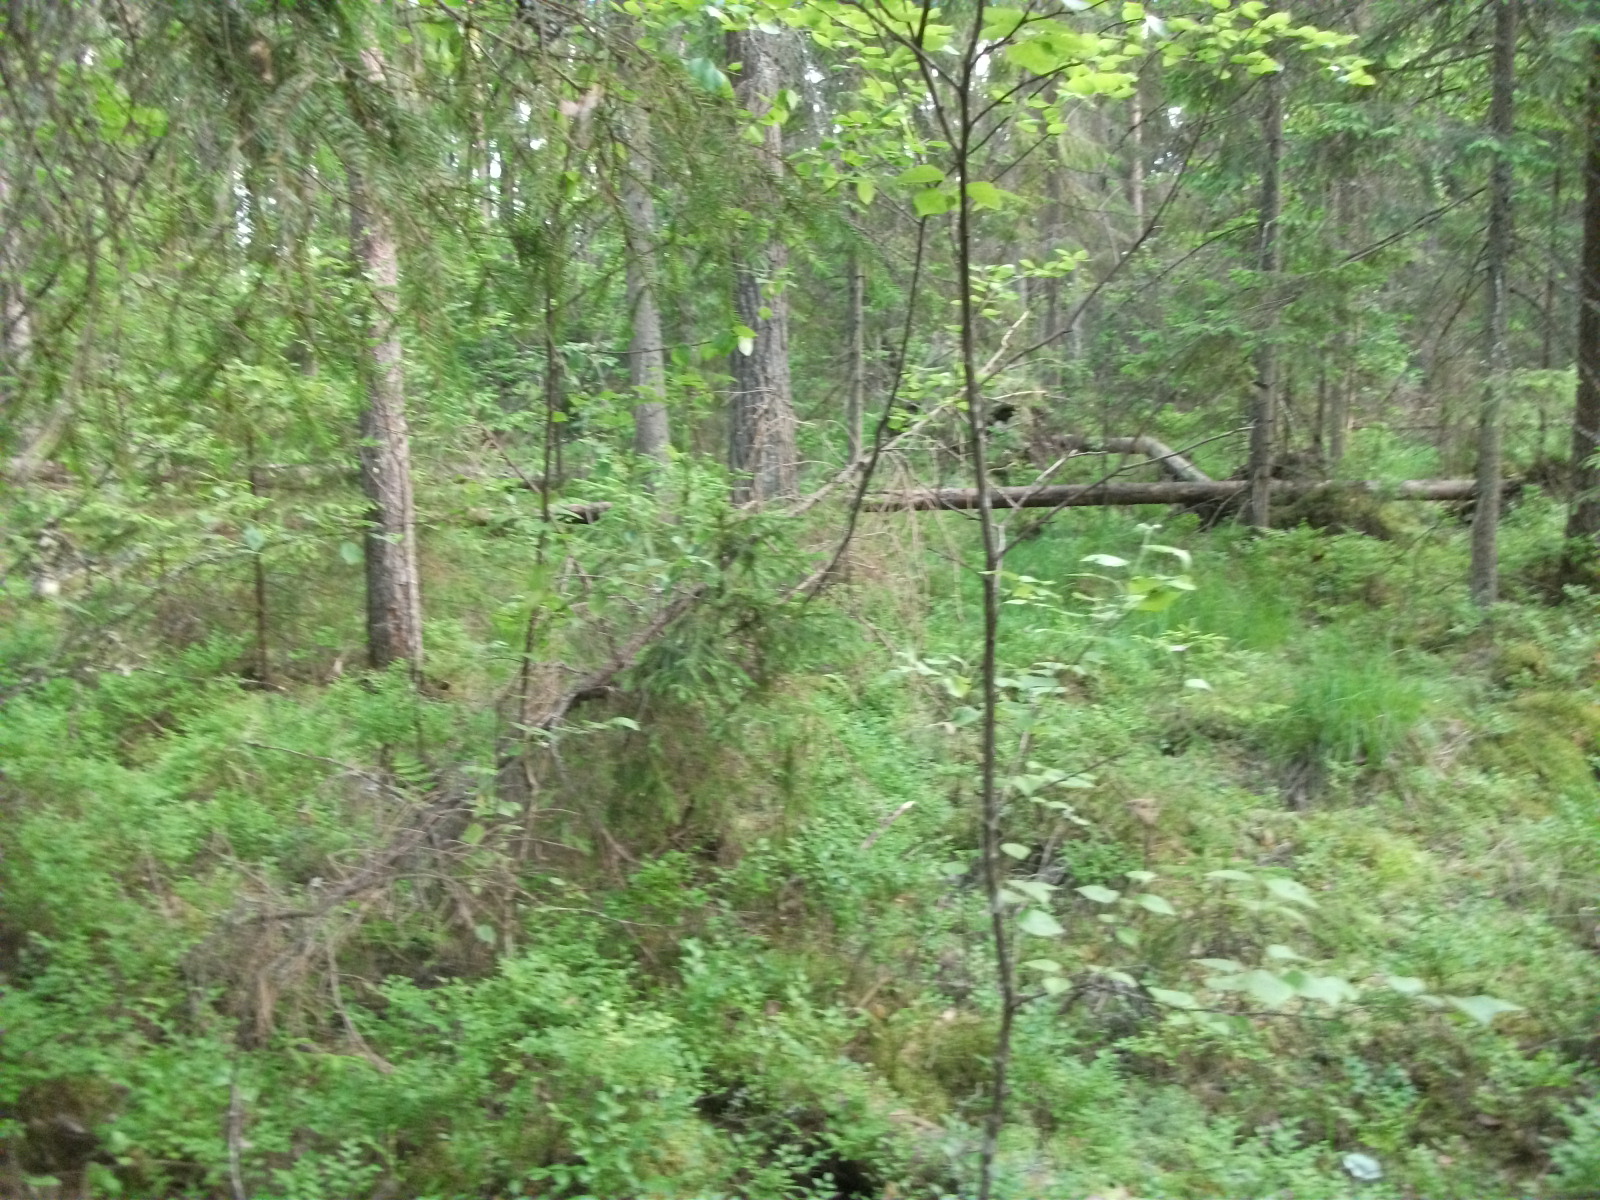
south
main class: Woodland
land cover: Other coniferous woodland
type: hemiboreal forest and nemoral coniferous forest and mixed broadleaved-coniferous forest
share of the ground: > 75 %
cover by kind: coniferous forest trees 80 %, herbaceous plants 10 %, shrubs 5 %, lichens and mosses 5 %
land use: Forestry
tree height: > 5 m
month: June
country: LV
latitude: 56.9578
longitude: 26.5754
